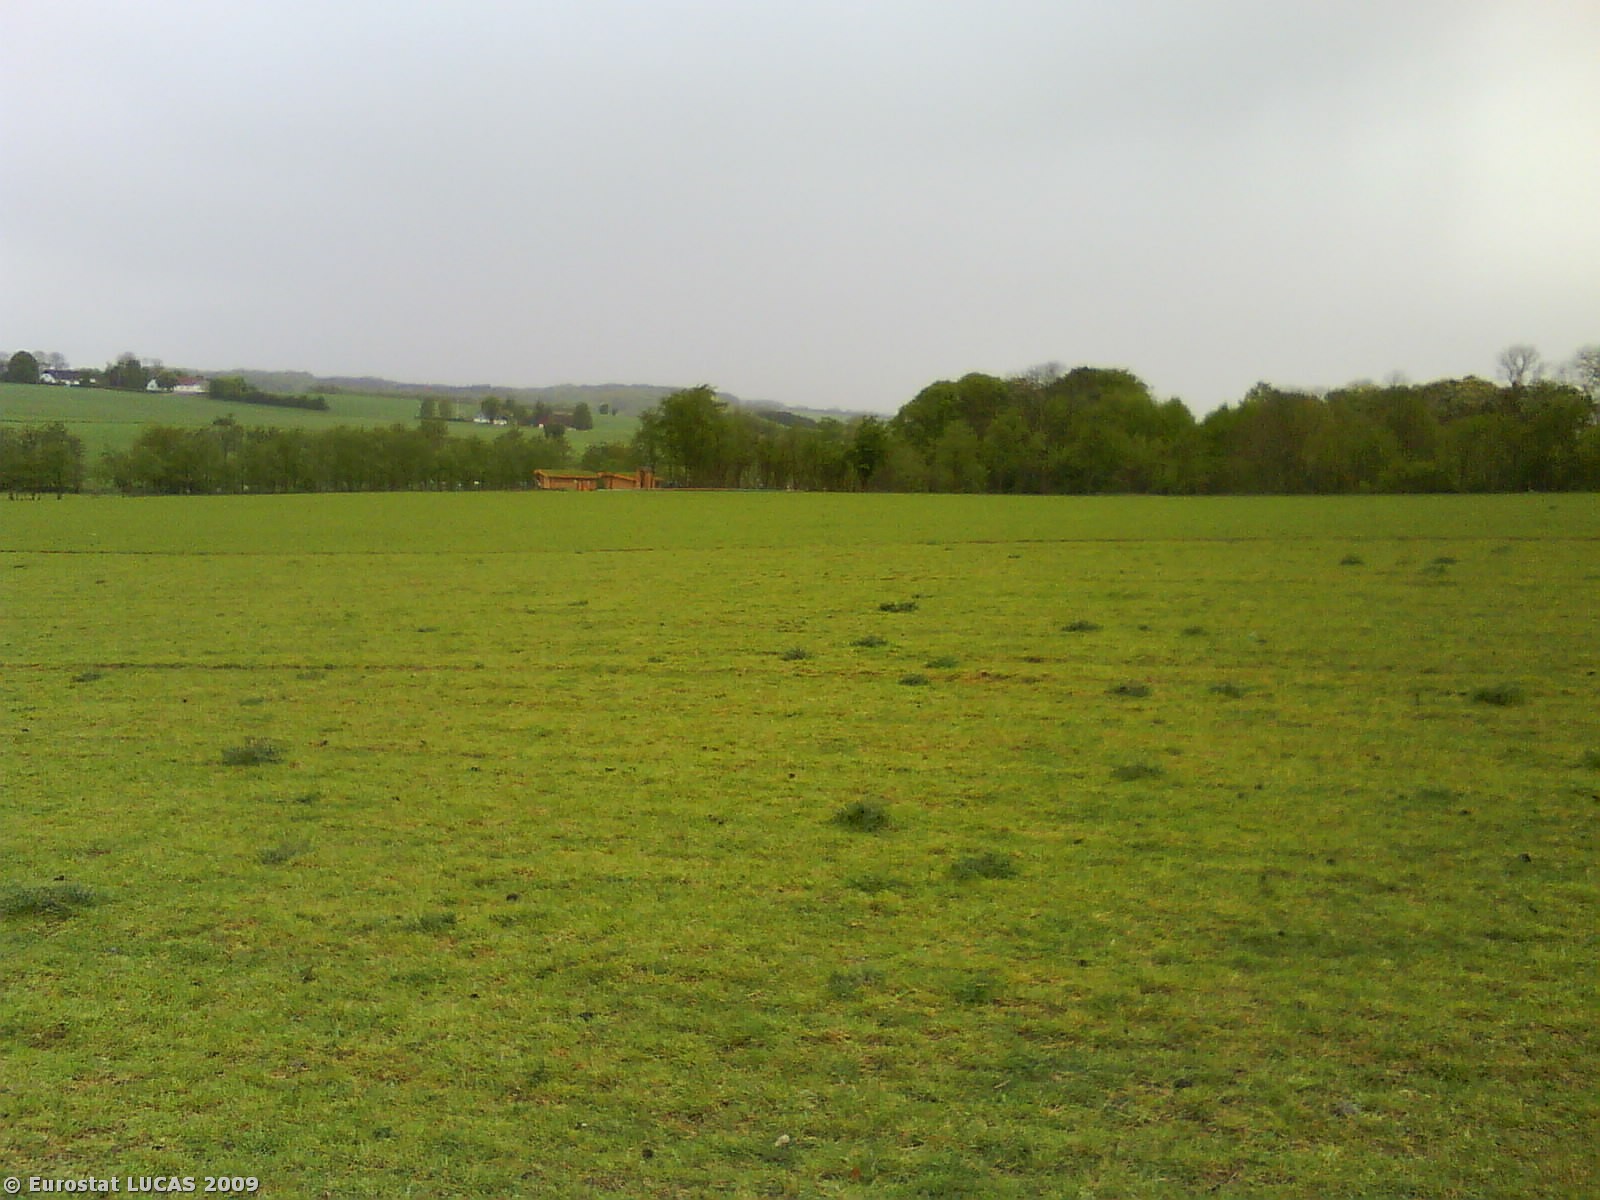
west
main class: Grassland
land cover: Grassland without tree/shrub cover
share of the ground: > 75 %
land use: Agriculture (excluding fallow land and kitchen gardens)
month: May
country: DK
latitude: 56.4034
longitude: 10.1133
